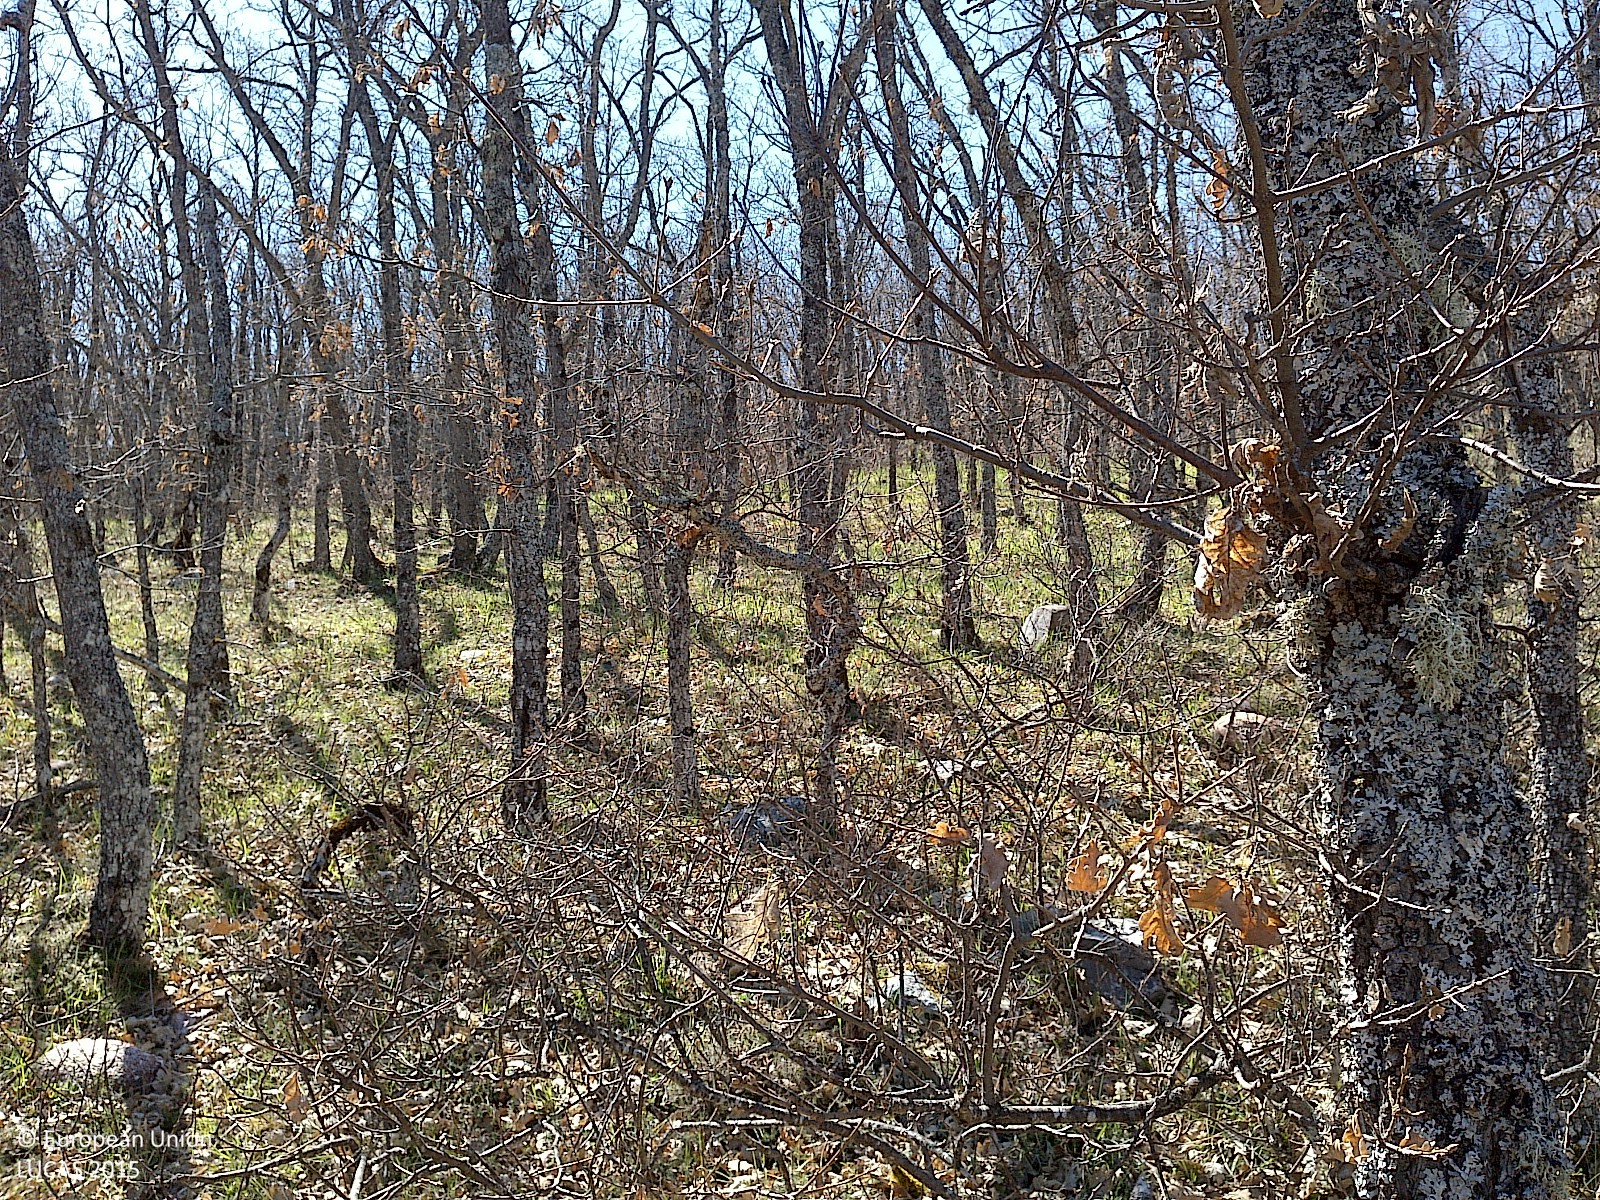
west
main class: Woodland
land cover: Broadleaved woodland
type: thermophilous deciduous forest
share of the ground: > 75 %
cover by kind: broadleaved forest trees 80 %, shrubs 10 %, herbaceous plants 10 %
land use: Forestry
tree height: < 5 m
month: April
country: ES
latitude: 42.1089
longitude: -3.2453
